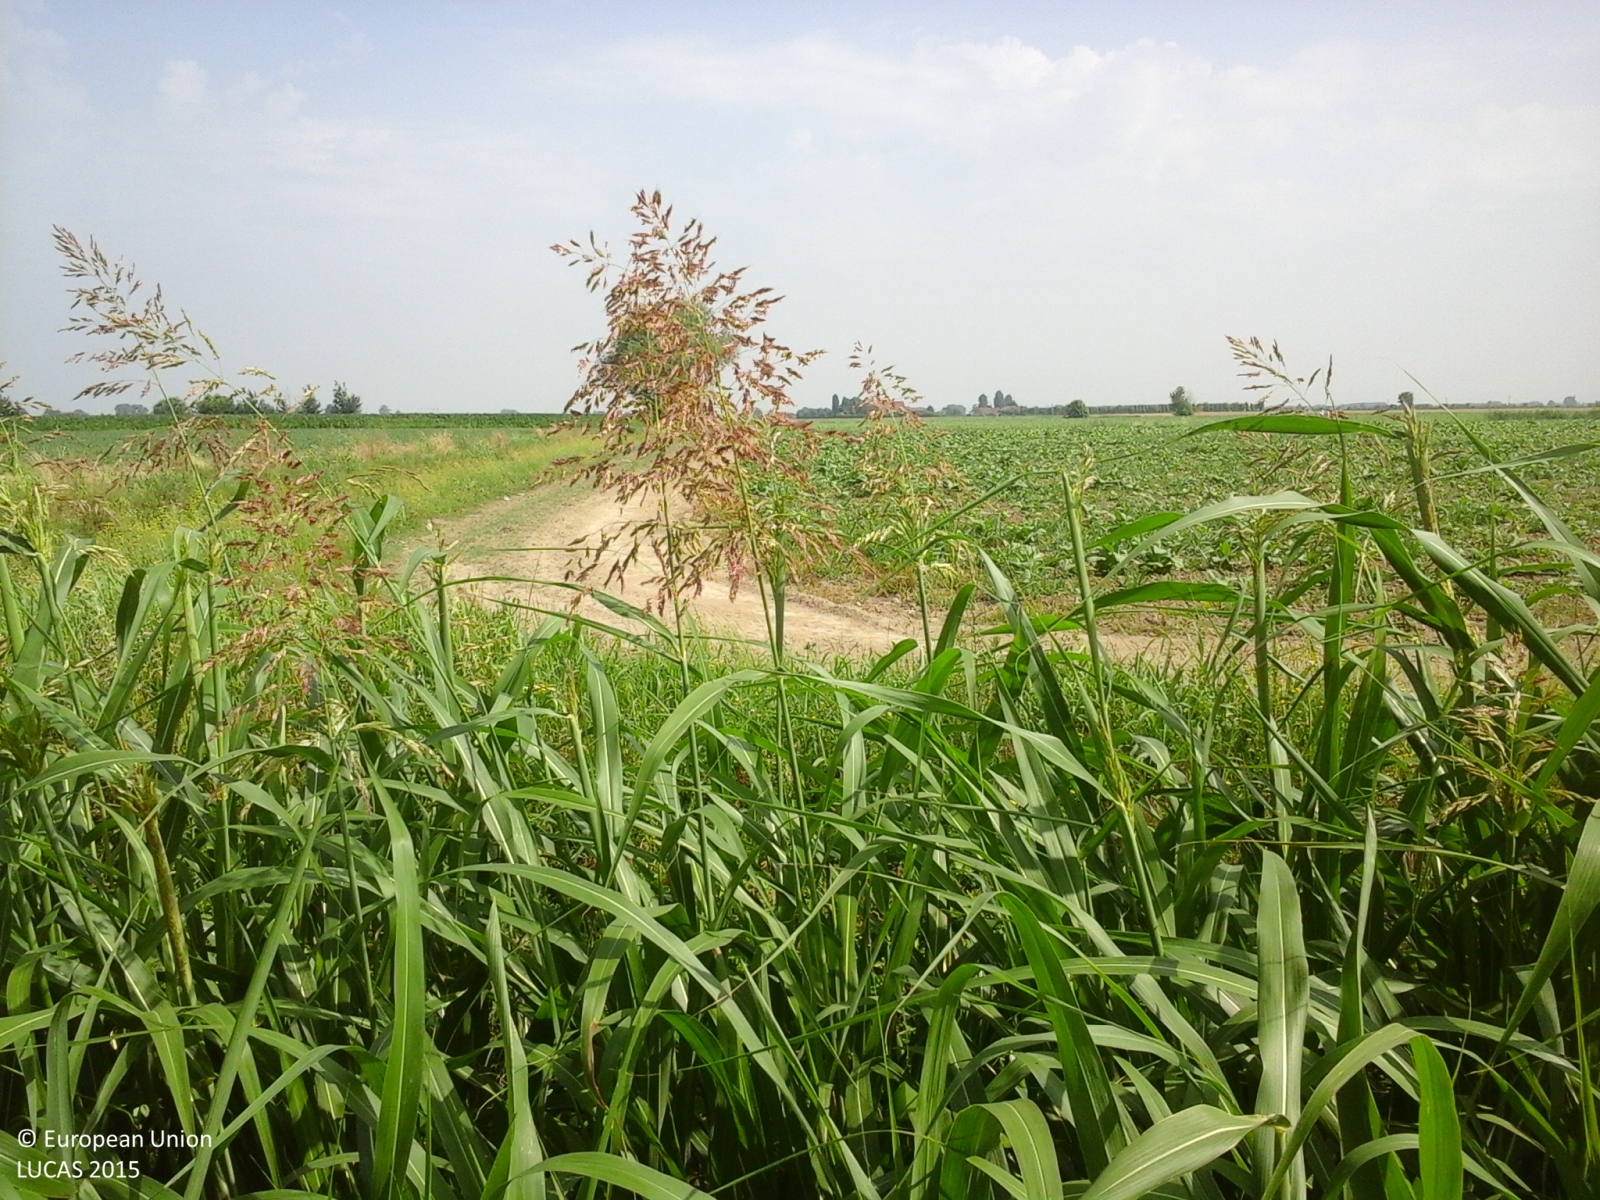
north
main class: Cropland
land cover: Maize
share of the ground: > 75 %
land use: Agriculture (excluding fallow land and kitchen gardens)
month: June
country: IT
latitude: 45.2102
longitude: 11.1057
